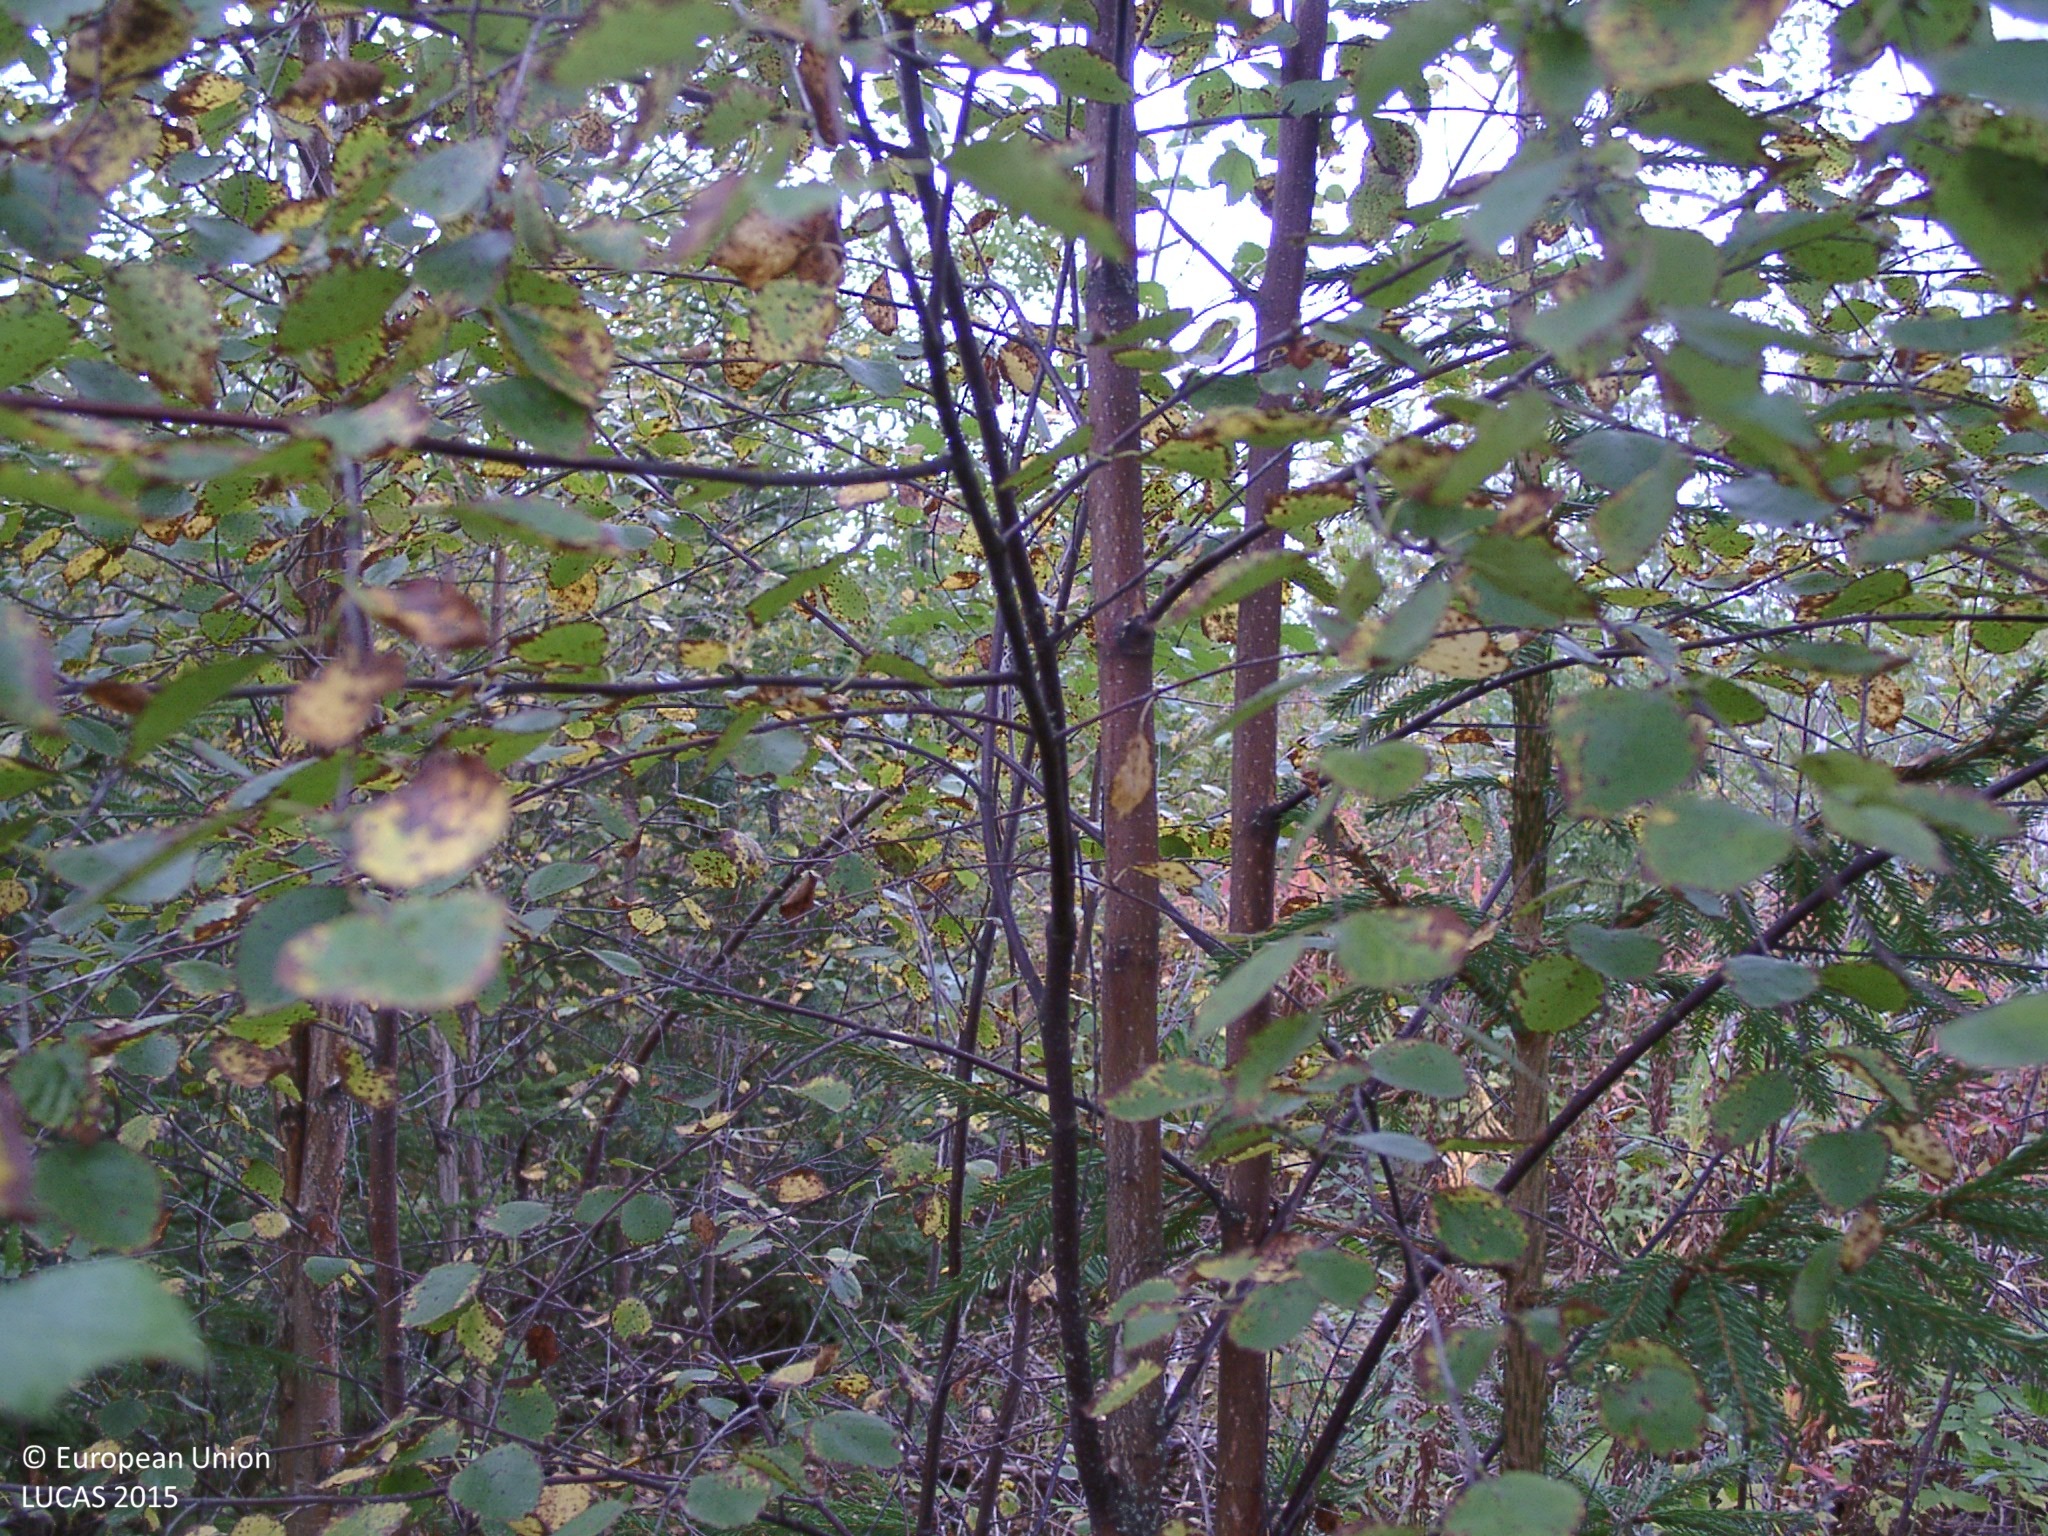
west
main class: Woodland
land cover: Broadleaved woodland
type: boreal forest
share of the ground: 50 - 75 %
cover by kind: broadleaved forest trees 60 %, lichens and mosses 20 %, coniferous forest trees 5 %, shrubs 5 %, herbaceous plants 5 %
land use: Forestry
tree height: < 5 m
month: September
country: FI
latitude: 62.8784
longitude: 25.2618
